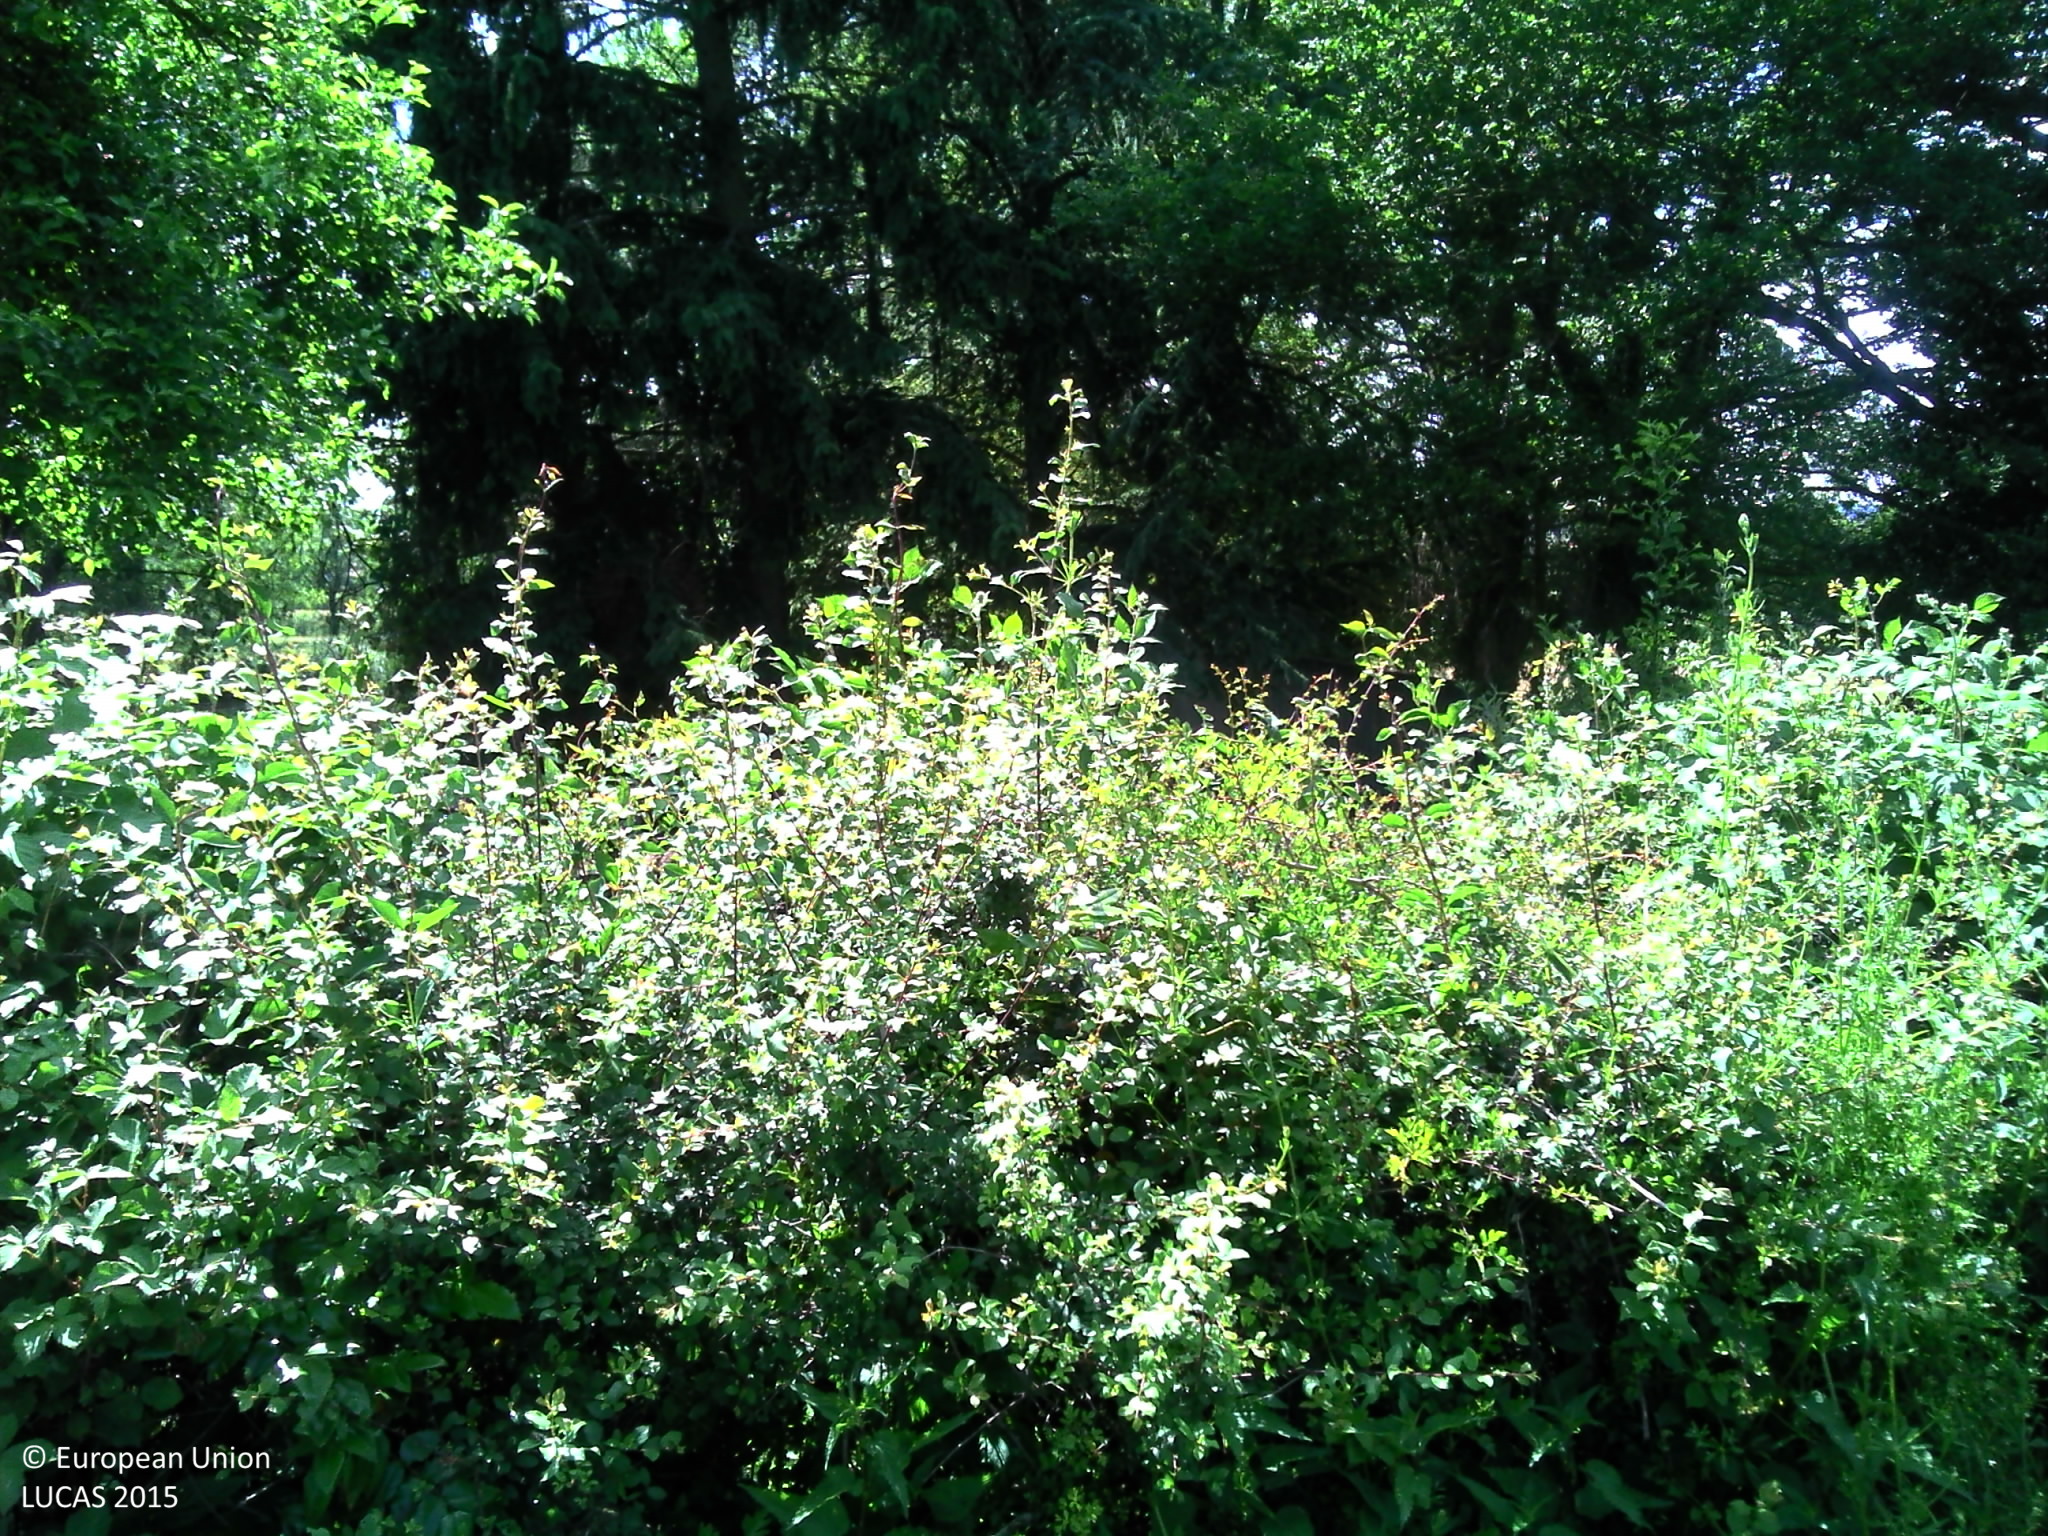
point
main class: Woodland
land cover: Spruce dominated mixed woodland
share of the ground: > 75 %
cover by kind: broadleaved forest trees 75 %, coniferous forest trees 25 %
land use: Residential
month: May
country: FR
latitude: 46.3211
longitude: 2.7365
